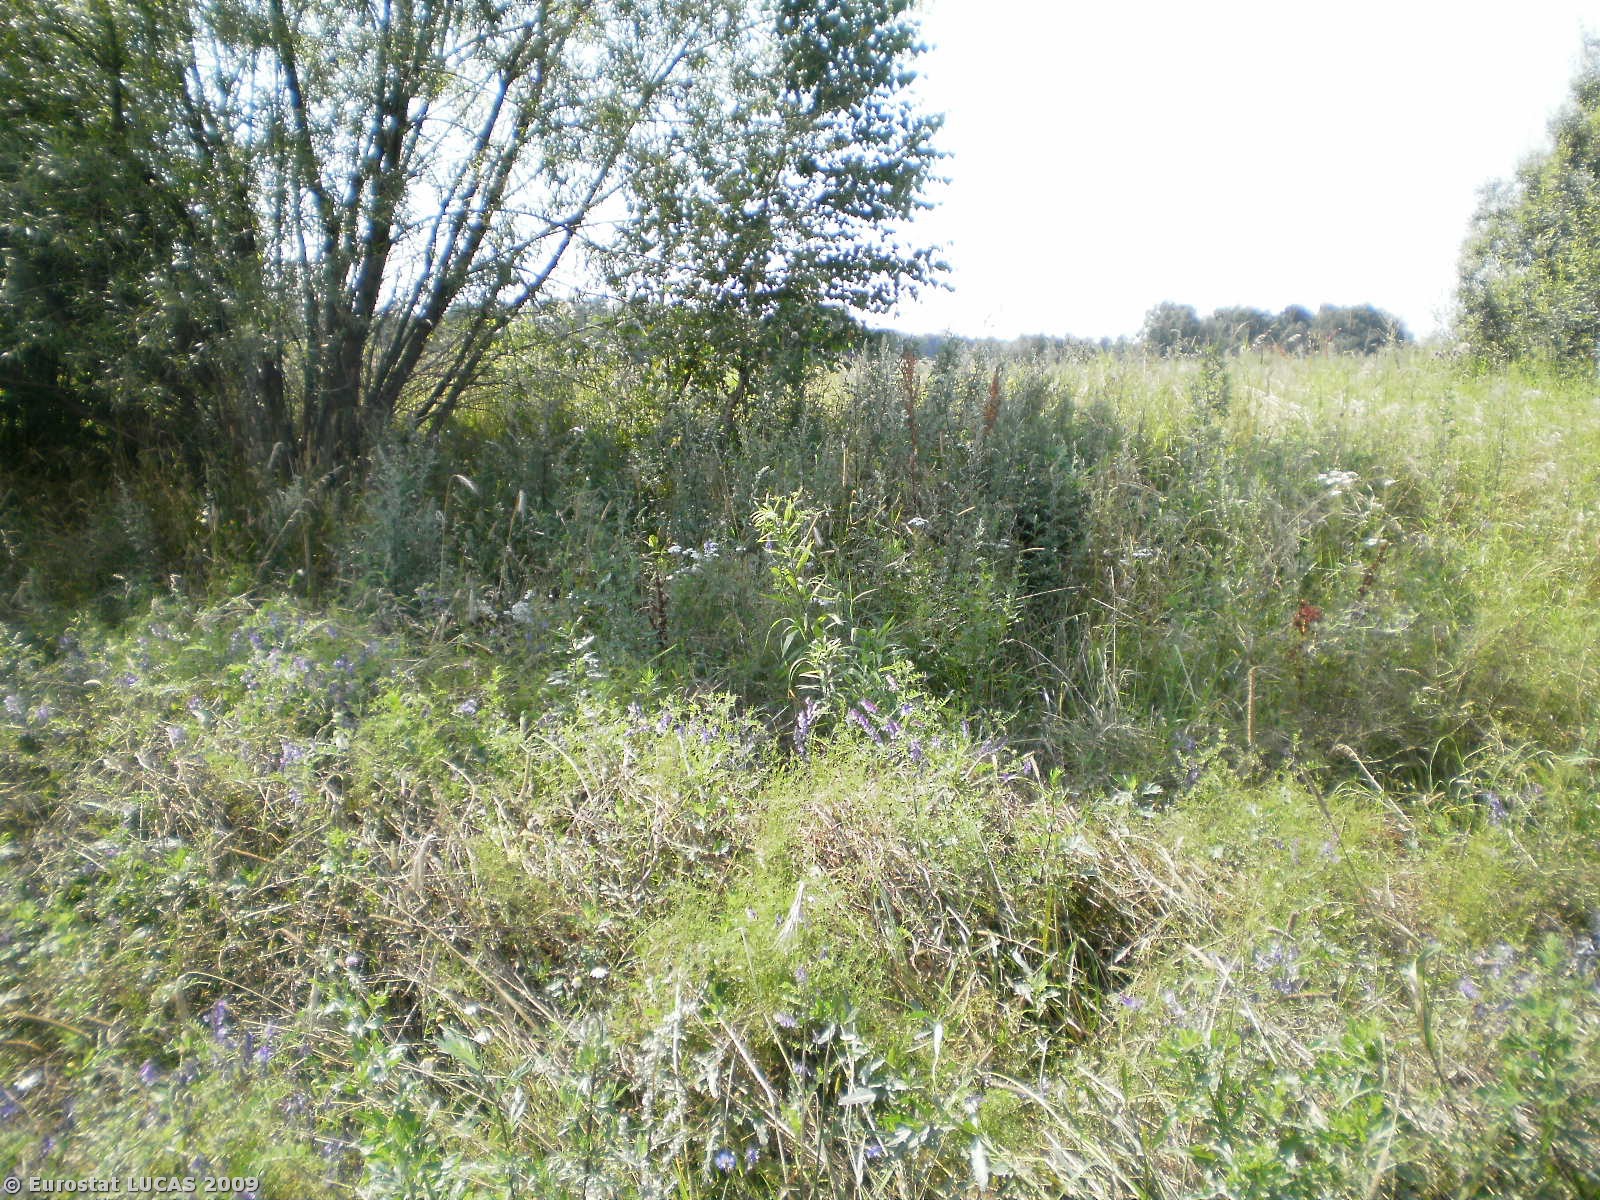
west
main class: Shrubland
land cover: Shrubland with sparse tree cover
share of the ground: > 75 %
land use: Unused
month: July
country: PL
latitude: 53.8929
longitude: 20.6444
